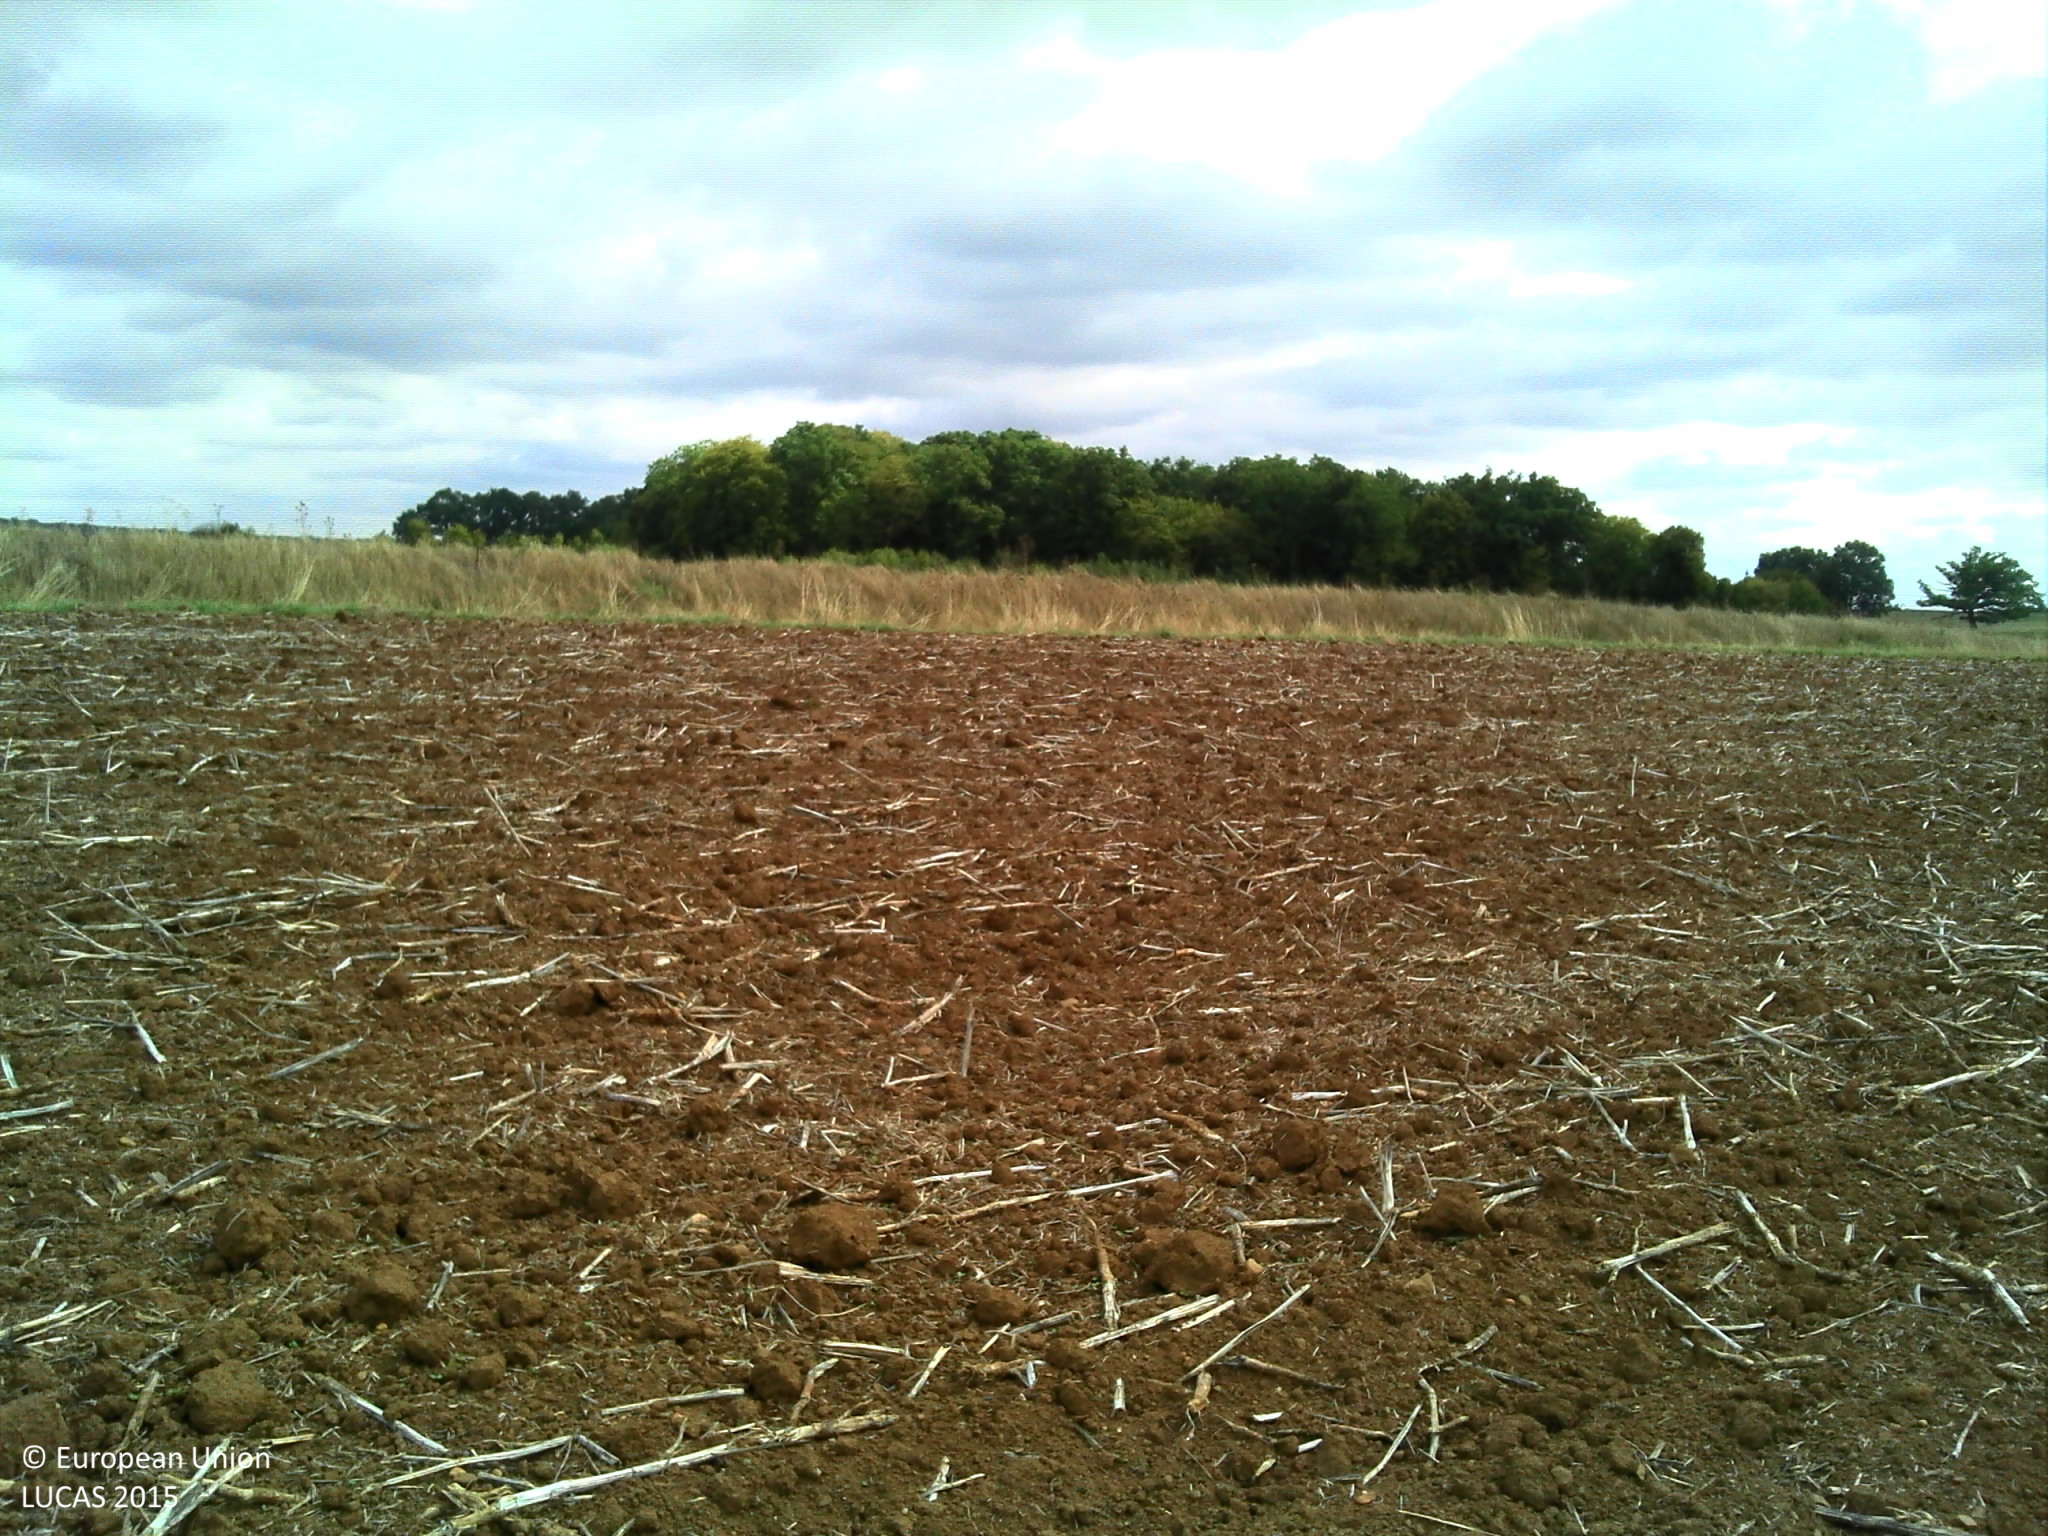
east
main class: Cropland
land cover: Rape and turnip rape
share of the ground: < 10 %
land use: Agriculture (excluding fallow land and kitchen gardens)
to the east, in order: Rape and turnip rape; Grass margins; Ditches and canals; Grass margins; Paved roads, cycling and walking lanes; Grass margins; Ditches and canals; Grass margins; Tracks; Grass margins; Rape and turnip rape; Temporary grasslands; Spontaneously vegetated surfaces; Ditches and canals; Spontaneously vegetated surfaces; Fences; Grassland without tree/shrub cover
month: September
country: FR
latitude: 48.5872
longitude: 6.1092
